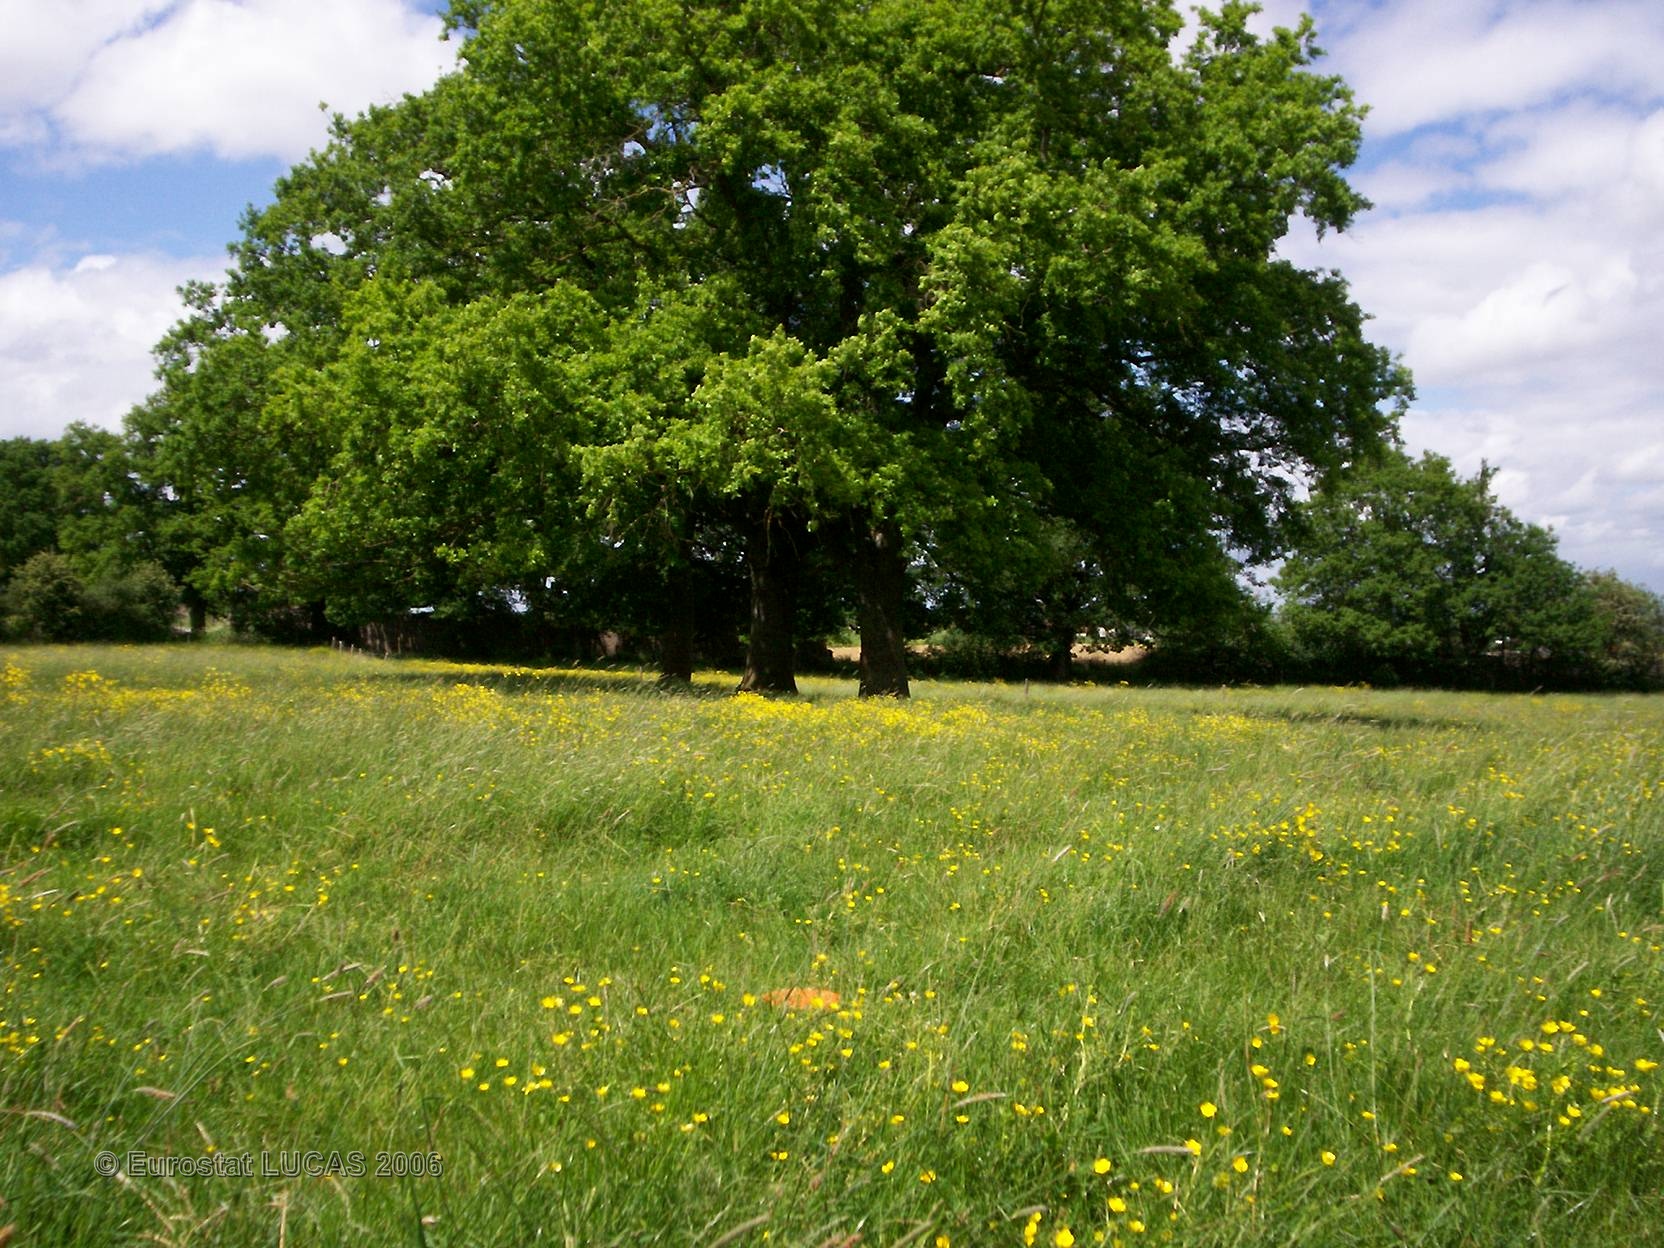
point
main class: Grassland
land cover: Grassland with sparse tree/shrub cover
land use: Agriculture (excluding fallow land and kitchen gardens)
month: May
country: FR
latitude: 47.2644
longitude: -1.0720
